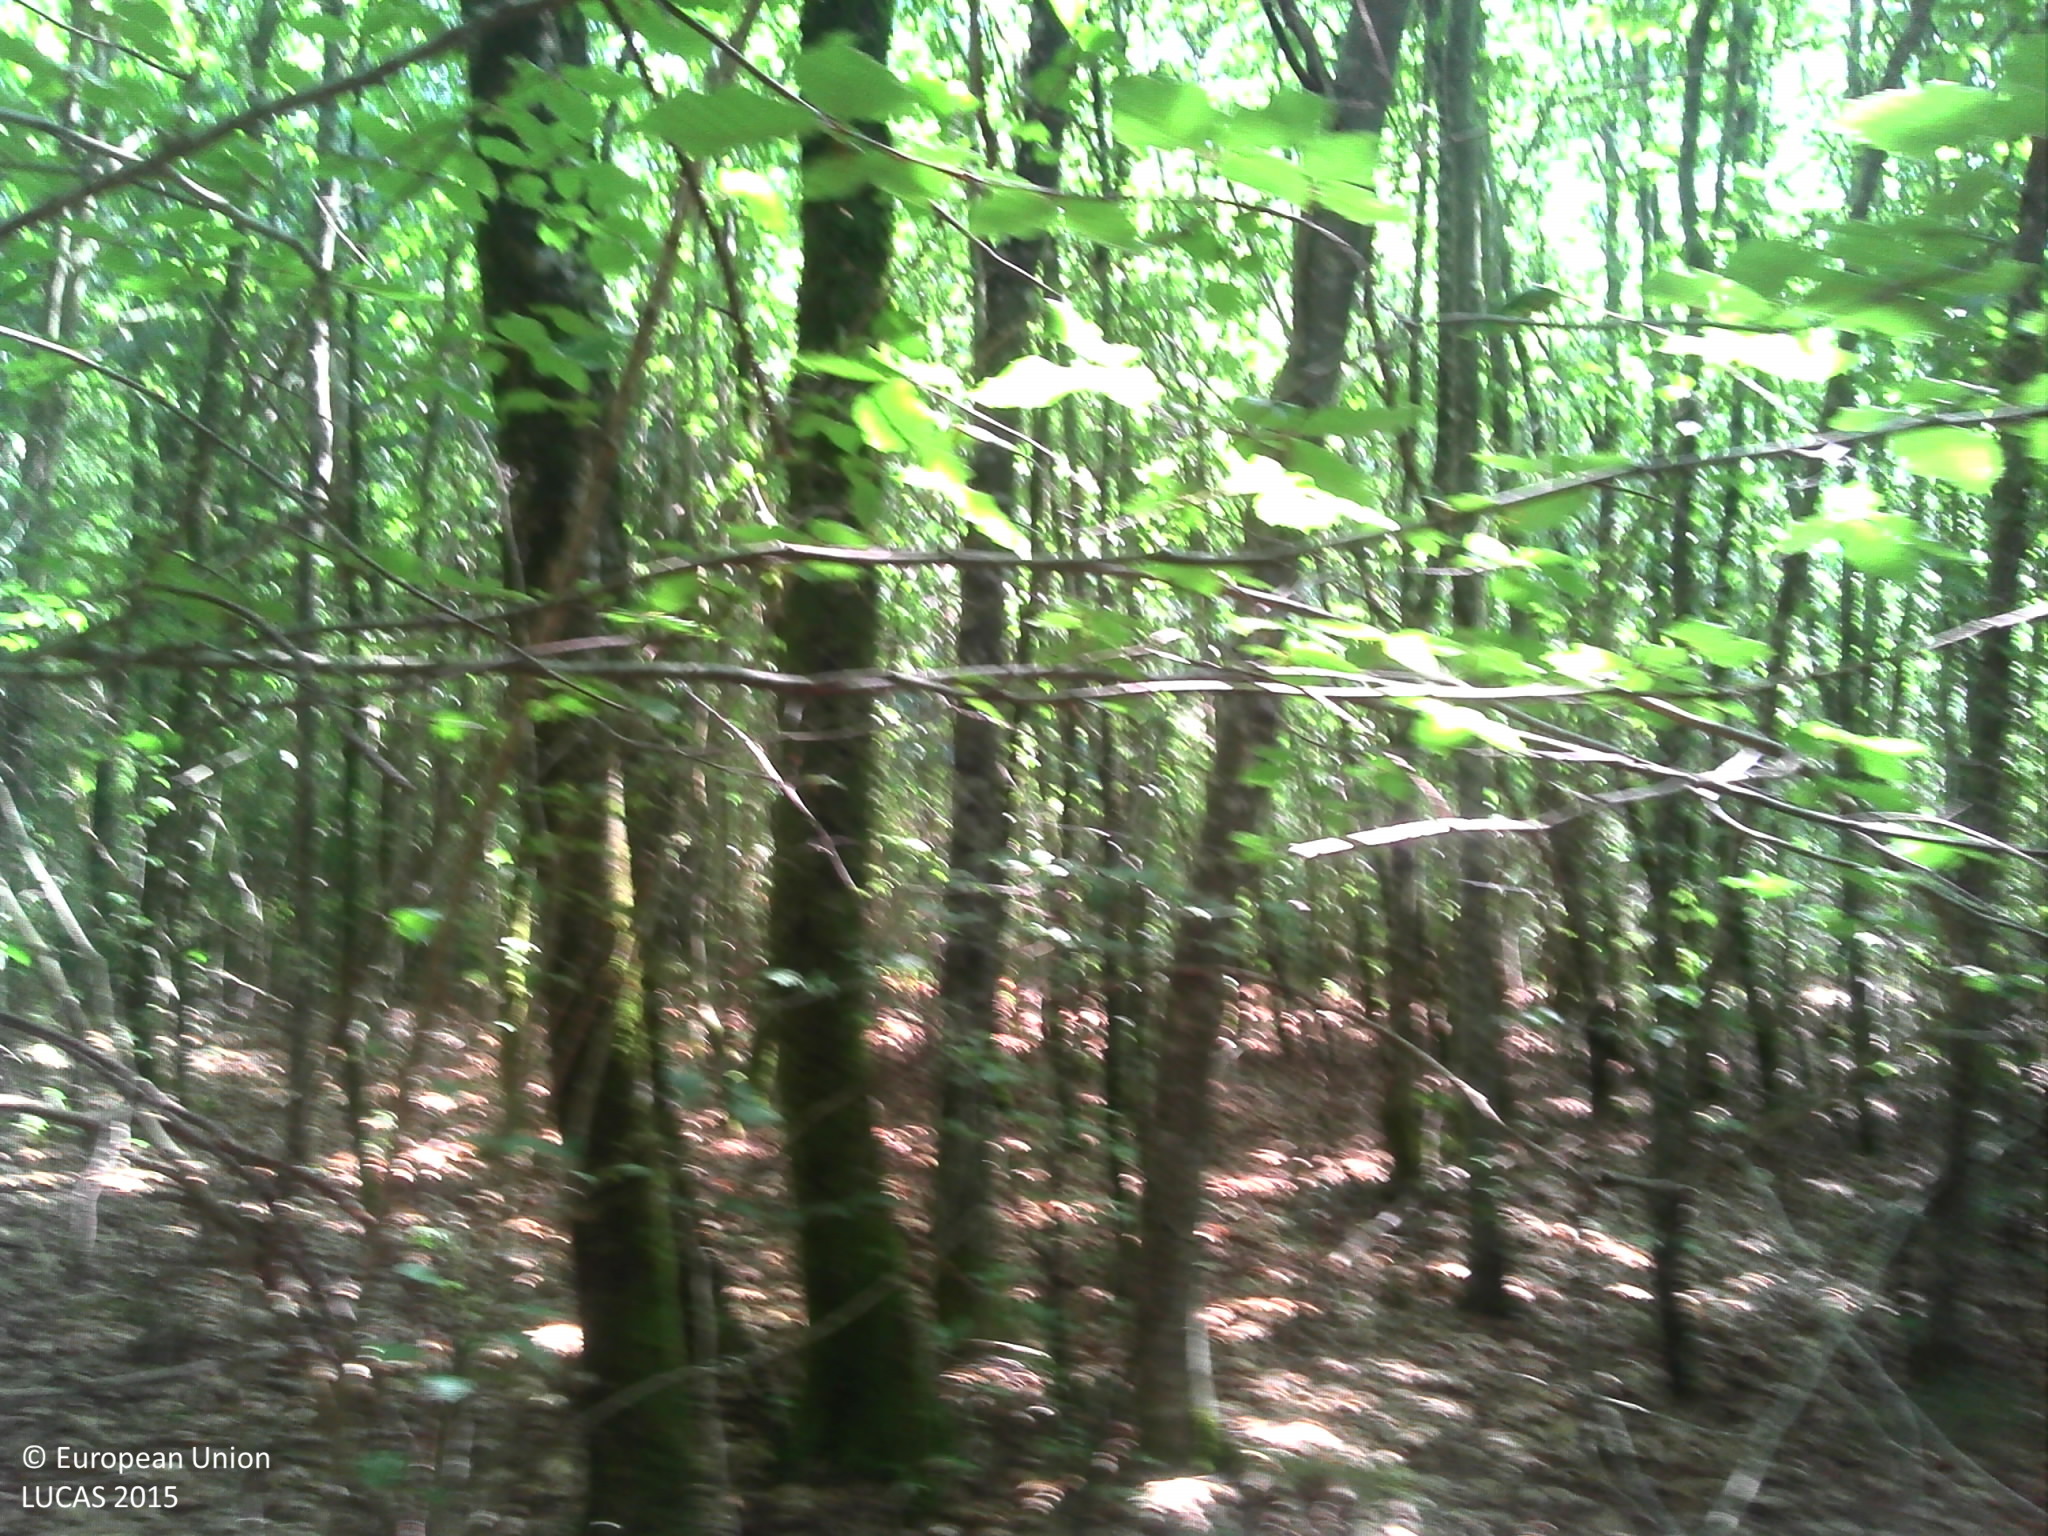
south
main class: Woodland
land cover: Broadleaved woodland
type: beech forest
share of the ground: > 75 %
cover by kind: broadleaved forest trees 95 %, lichens and mosses 5 %
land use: Forestry
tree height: > 5 m
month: July
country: FR
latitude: 47.9661
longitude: 5.0033
